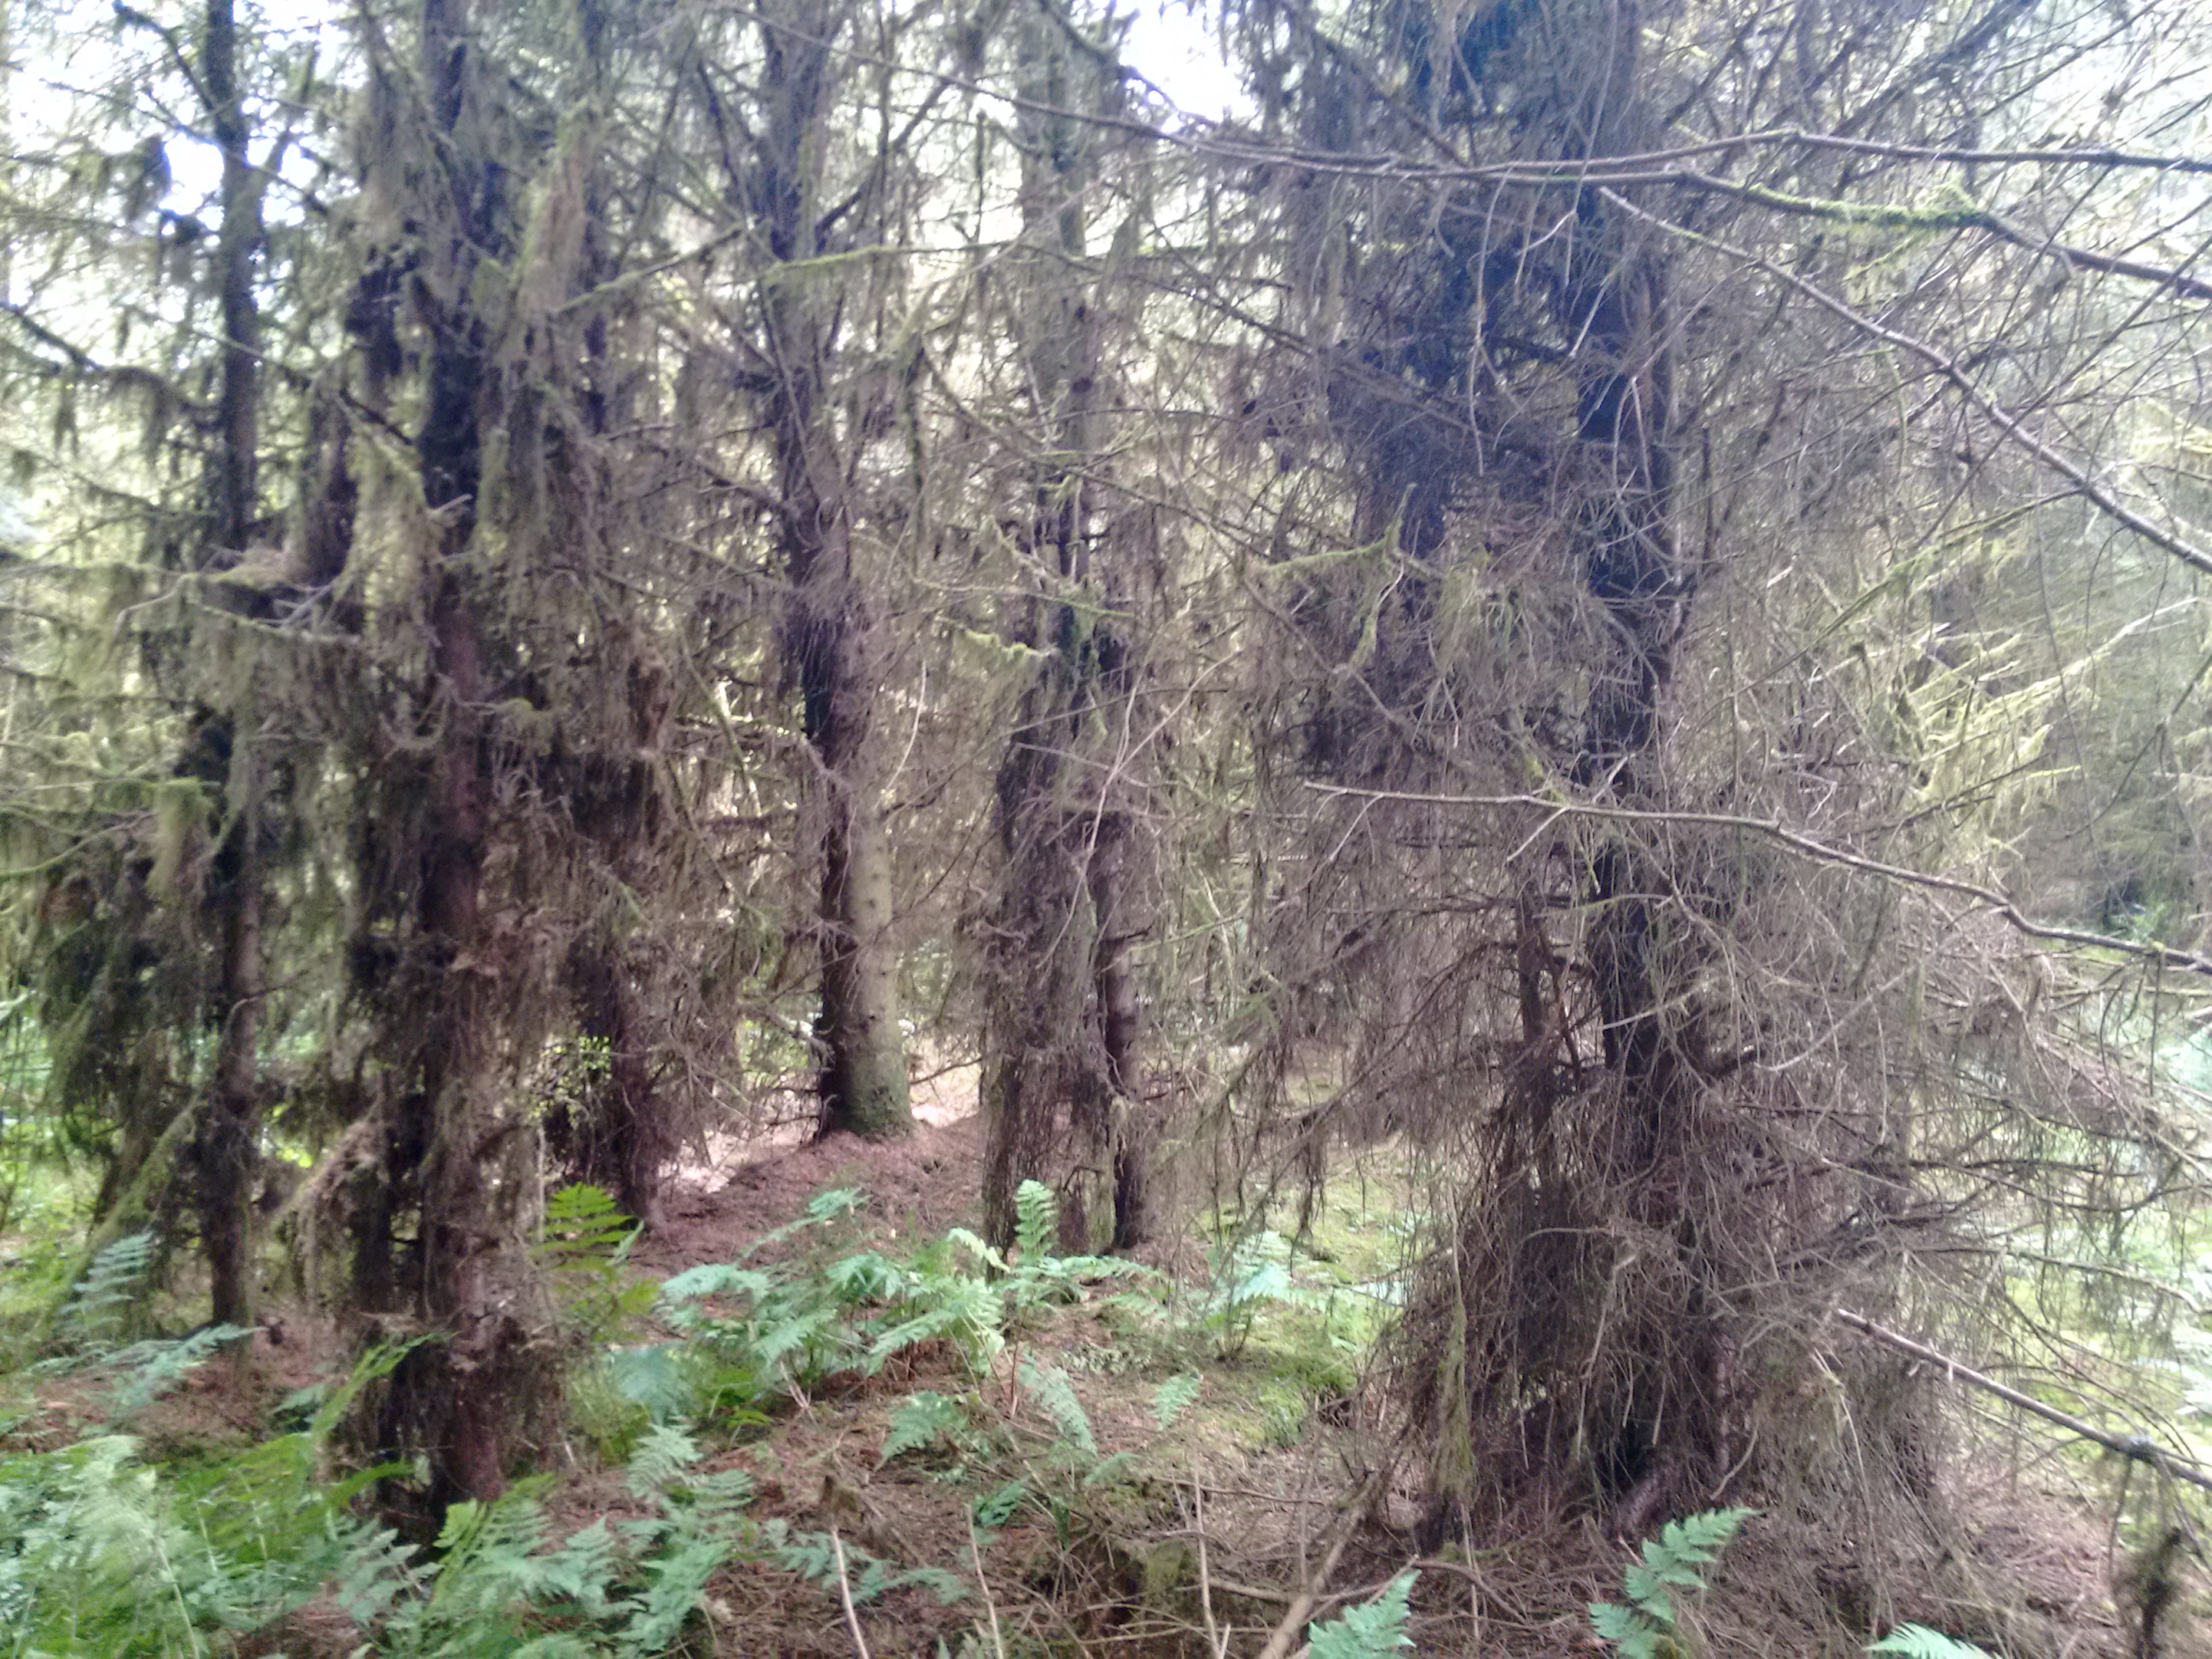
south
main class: Woodland
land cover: Spruce dominated coniferous woodland
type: exotic forest
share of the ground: > 75 %
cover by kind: coniferous forest trees 100 %
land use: Forestry
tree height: > 5 m
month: July
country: GB
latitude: 54.5905
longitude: -7.0559
